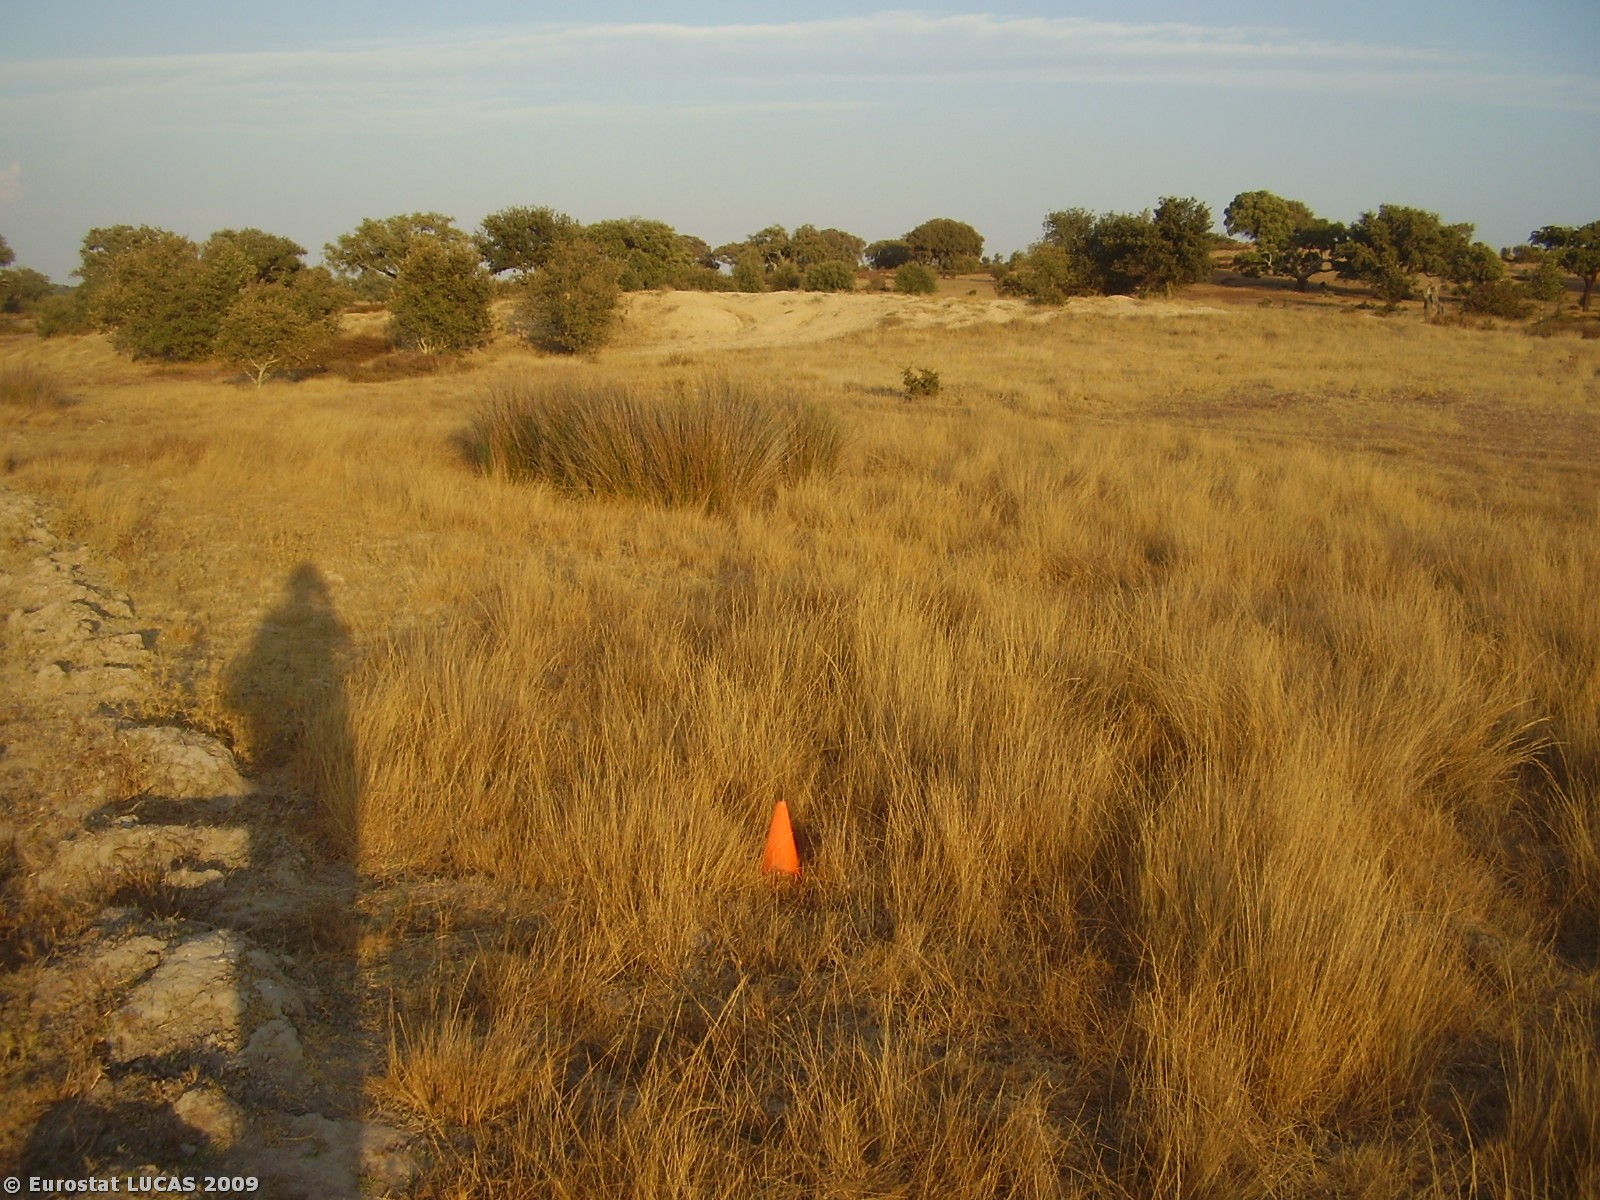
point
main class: Grassland
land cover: Grassland without tree/shrub cover
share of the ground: > 75 %
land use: Fallow land
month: August
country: PT
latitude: 37.9115
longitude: -8.4316
